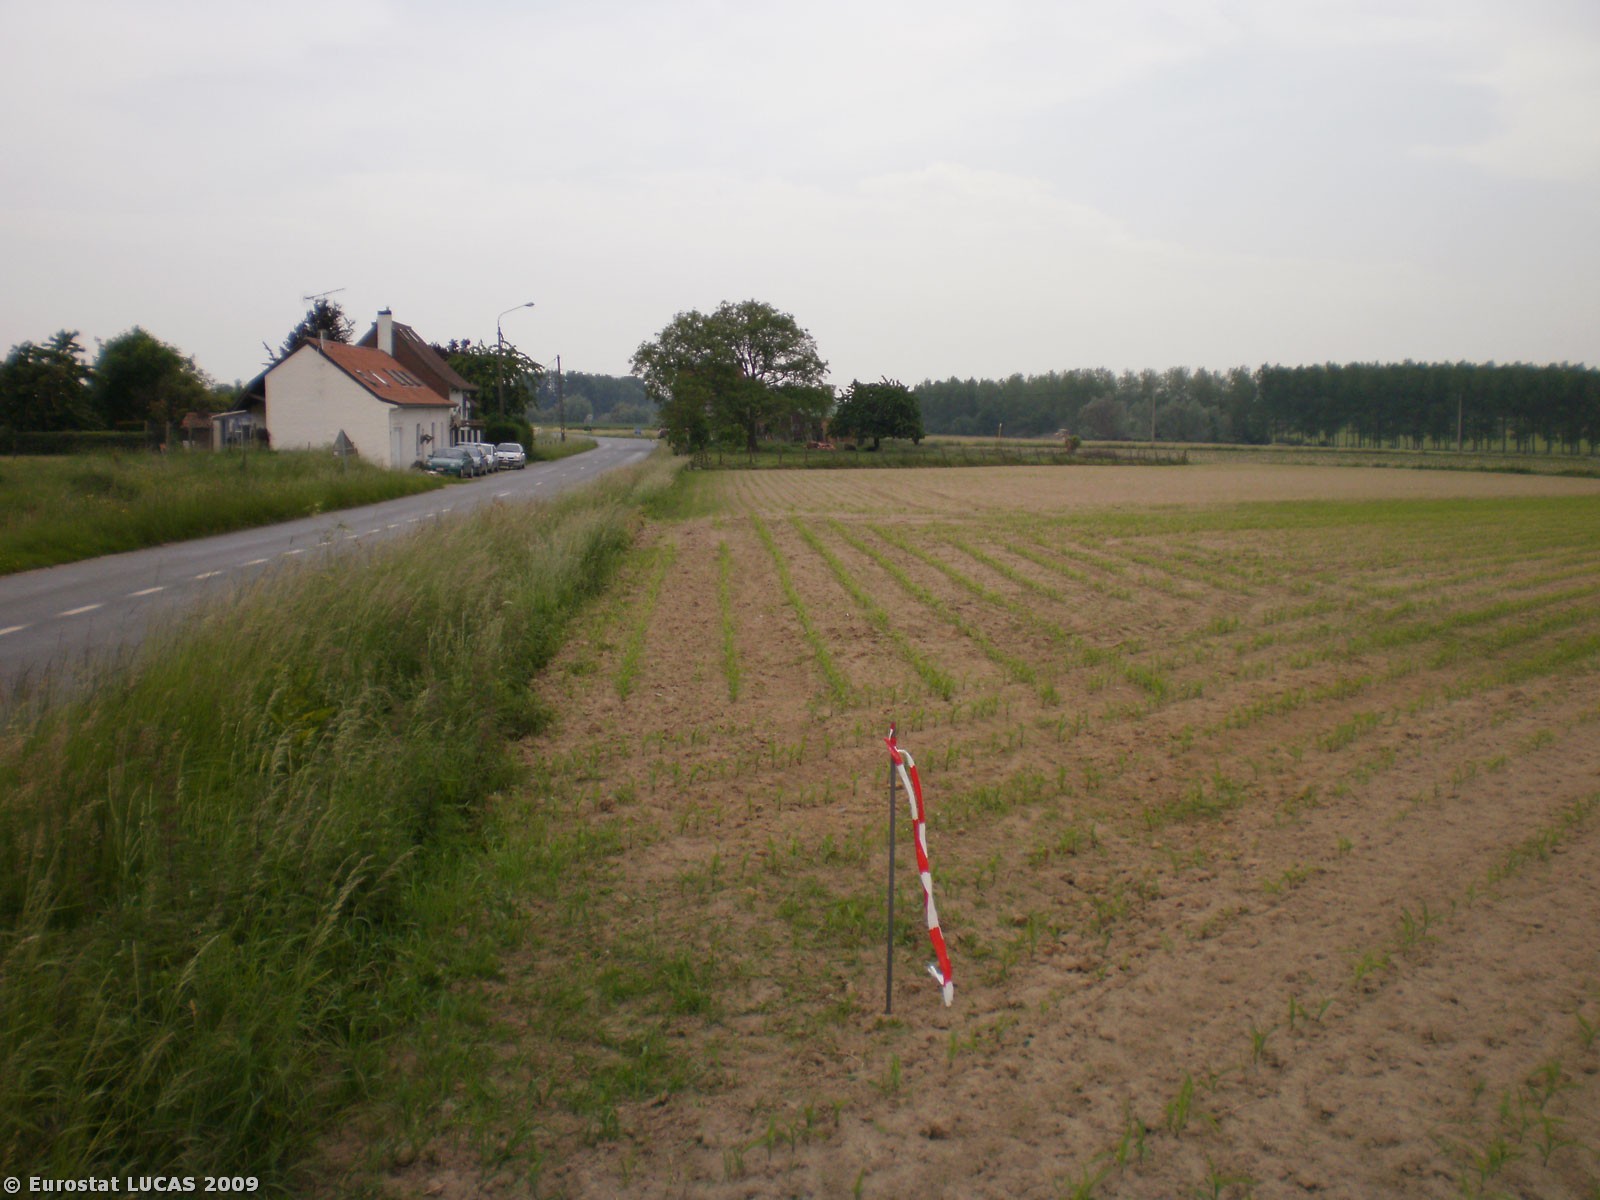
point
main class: Cropland
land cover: Maize
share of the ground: < 10 %
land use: Agriculture (excluding fallow land and kitchen gardens)
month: May
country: BE
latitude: 50.6981
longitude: 3.7497
